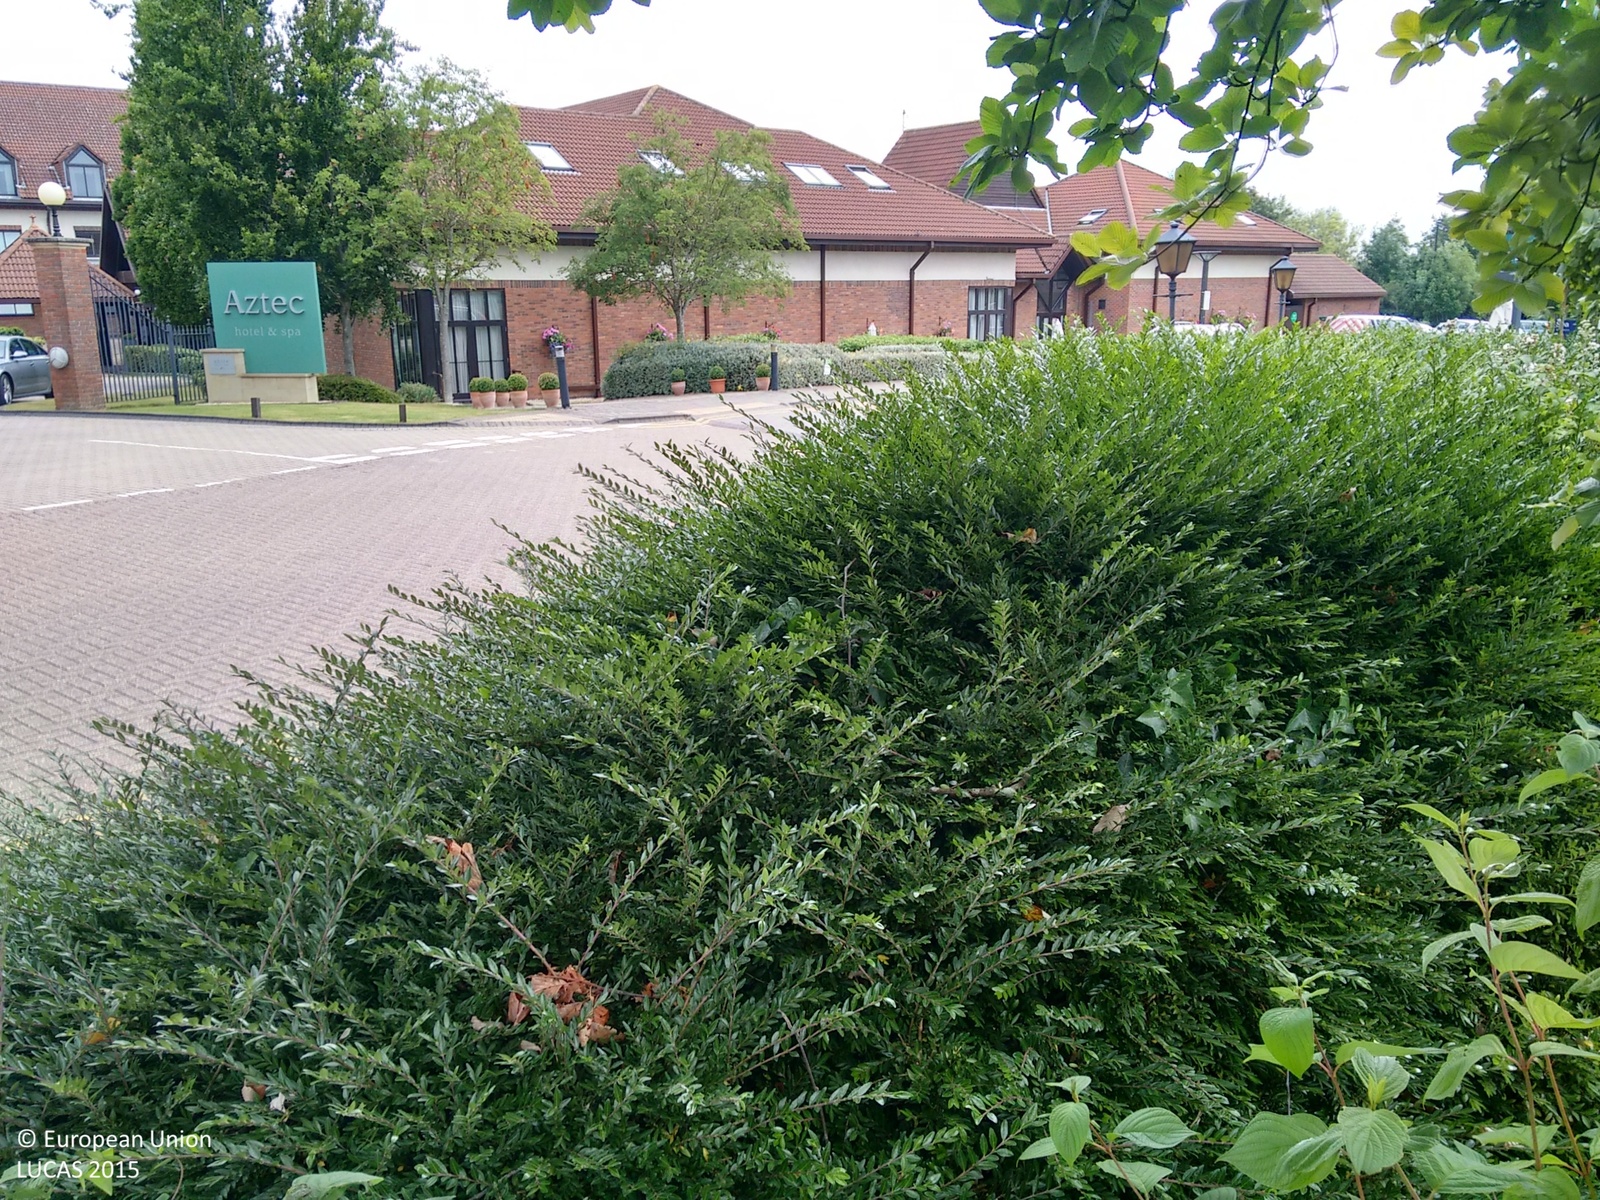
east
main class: Woodland
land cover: Broadleaved woodland
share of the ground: > 75 %
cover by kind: broadleaved forest trees 100 %
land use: Semi-natural and natural areas not in use
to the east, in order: Broadleaved woodland; Artificial constructions in urban areas
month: July
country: GB
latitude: 51.5423
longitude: -2.5688
